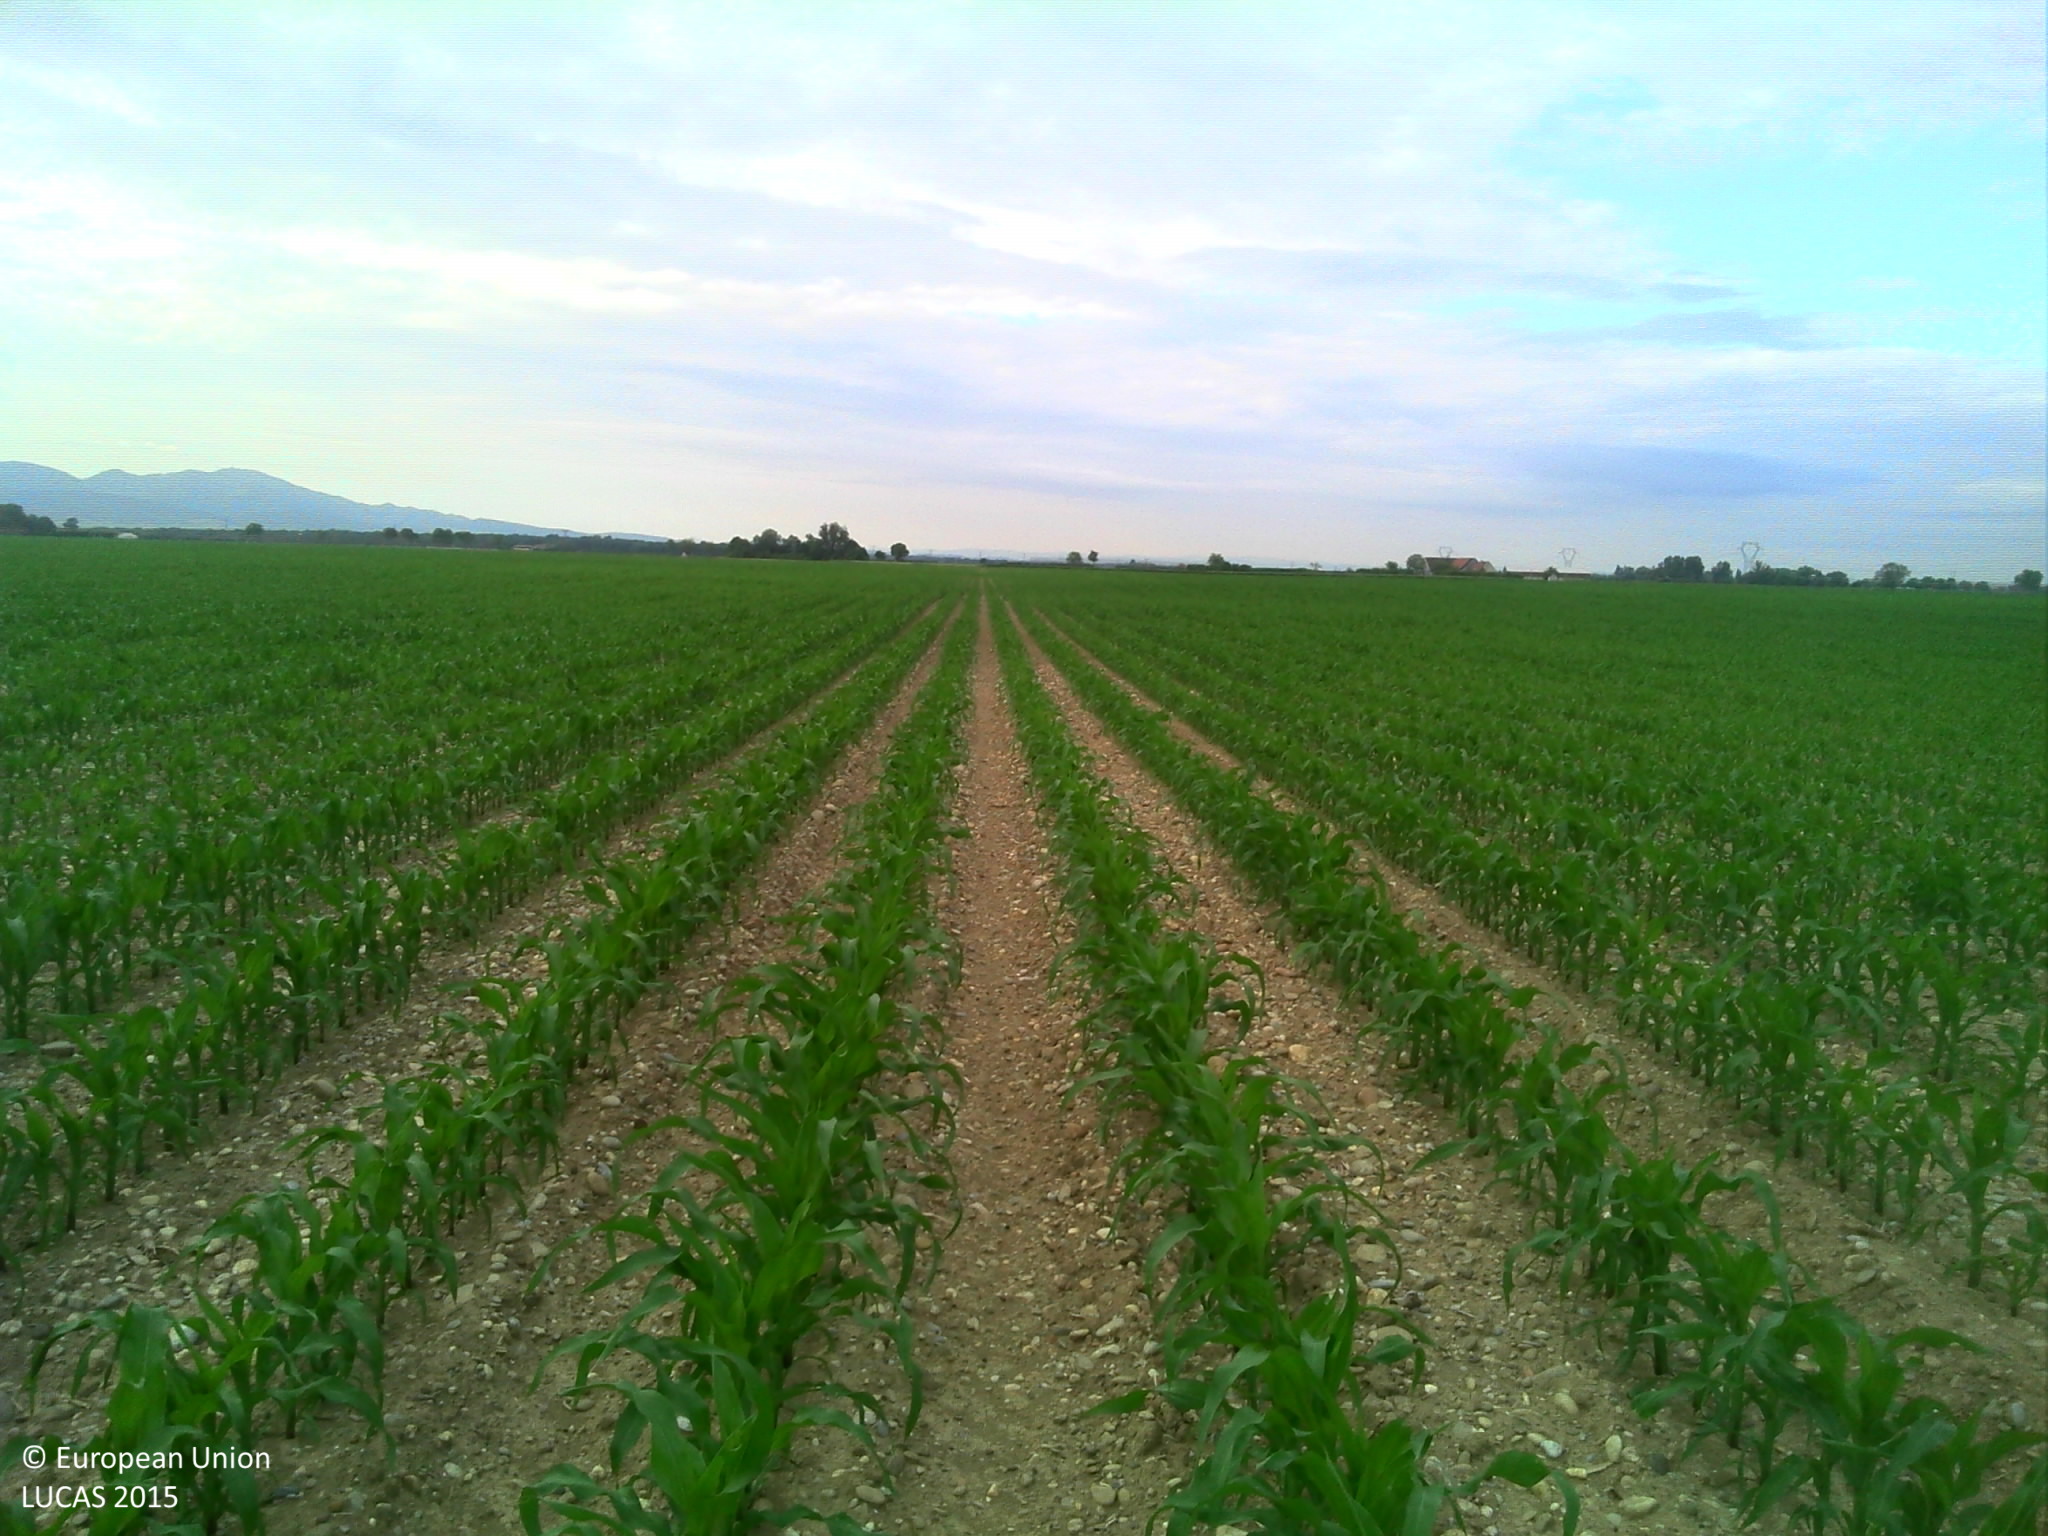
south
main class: Cropland
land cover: Maize
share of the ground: 10 - 25 %
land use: Agriculture (excluding fallow land and kitchen gardens)
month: June
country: FR
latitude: 47.9989
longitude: 7.5754
